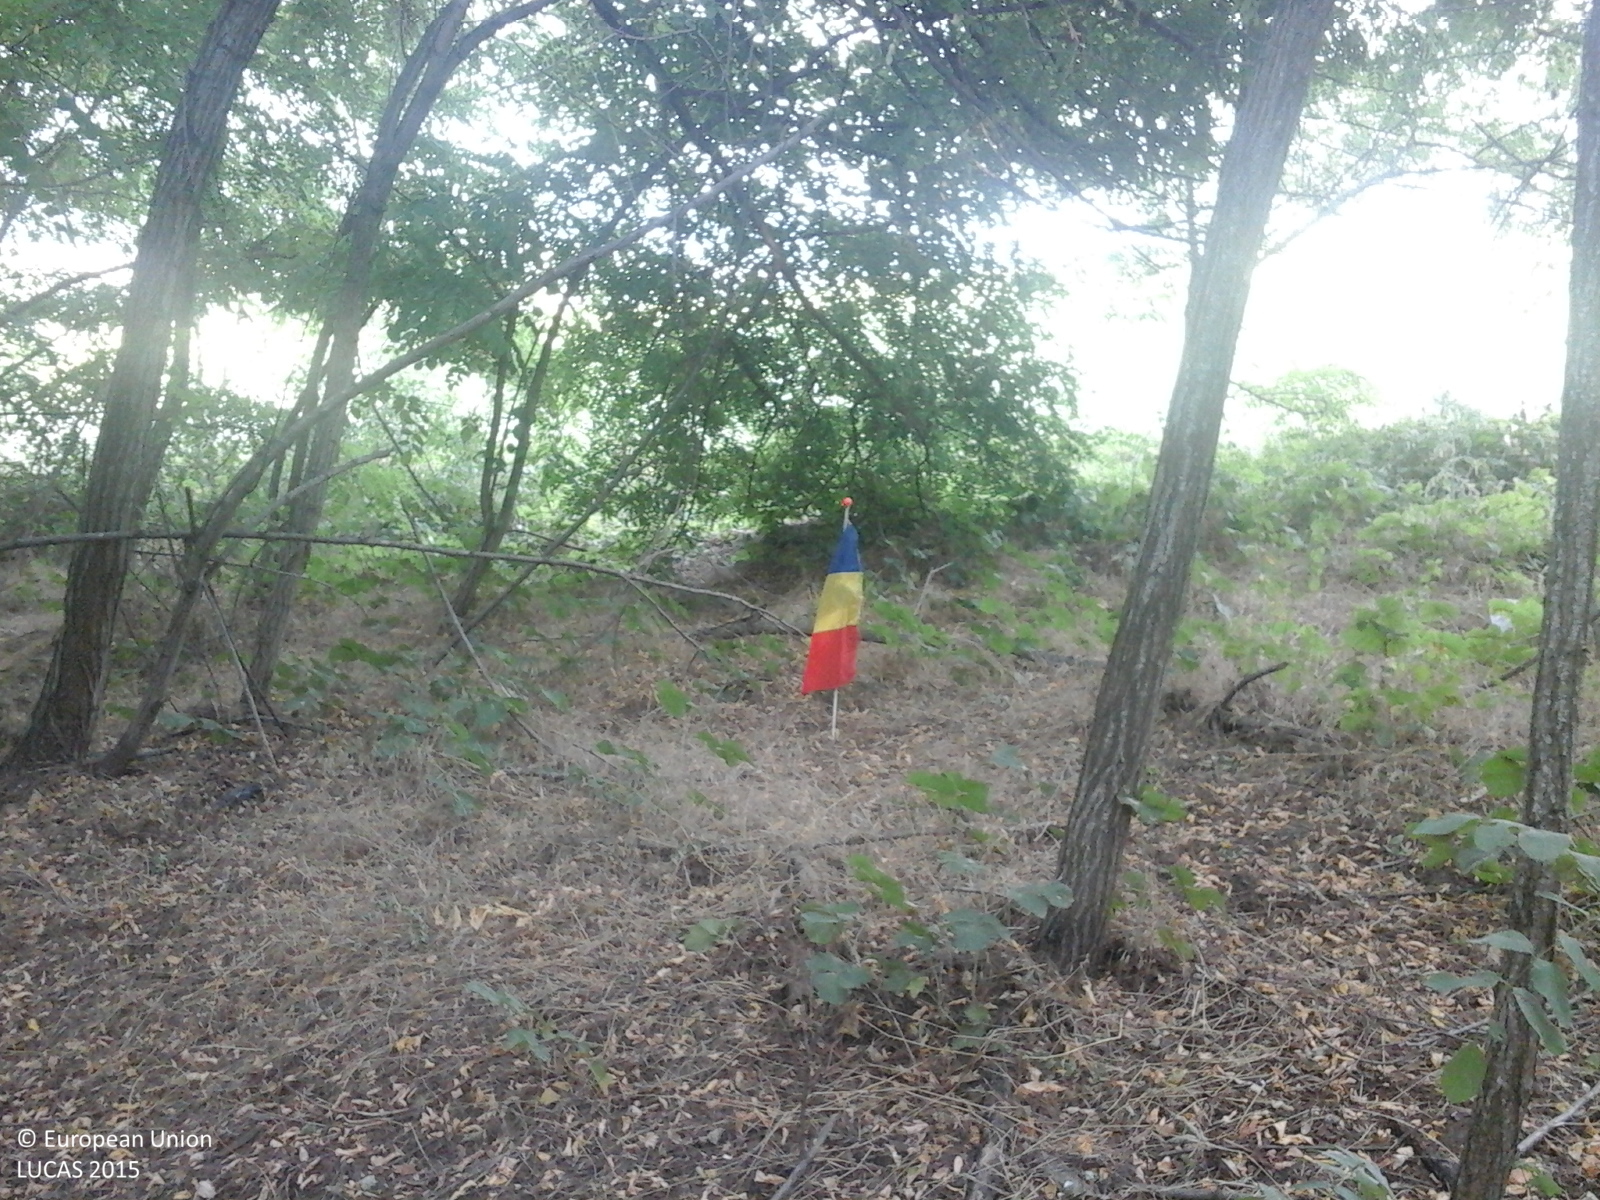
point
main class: Woodland
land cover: Broadleaved woodland
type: exotic forest
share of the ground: > 75 %
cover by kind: broadleaved forest trees 100 %
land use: Forestry
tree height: > 5 m
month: July
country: RO
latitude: 45.1296
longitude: 28.3714
